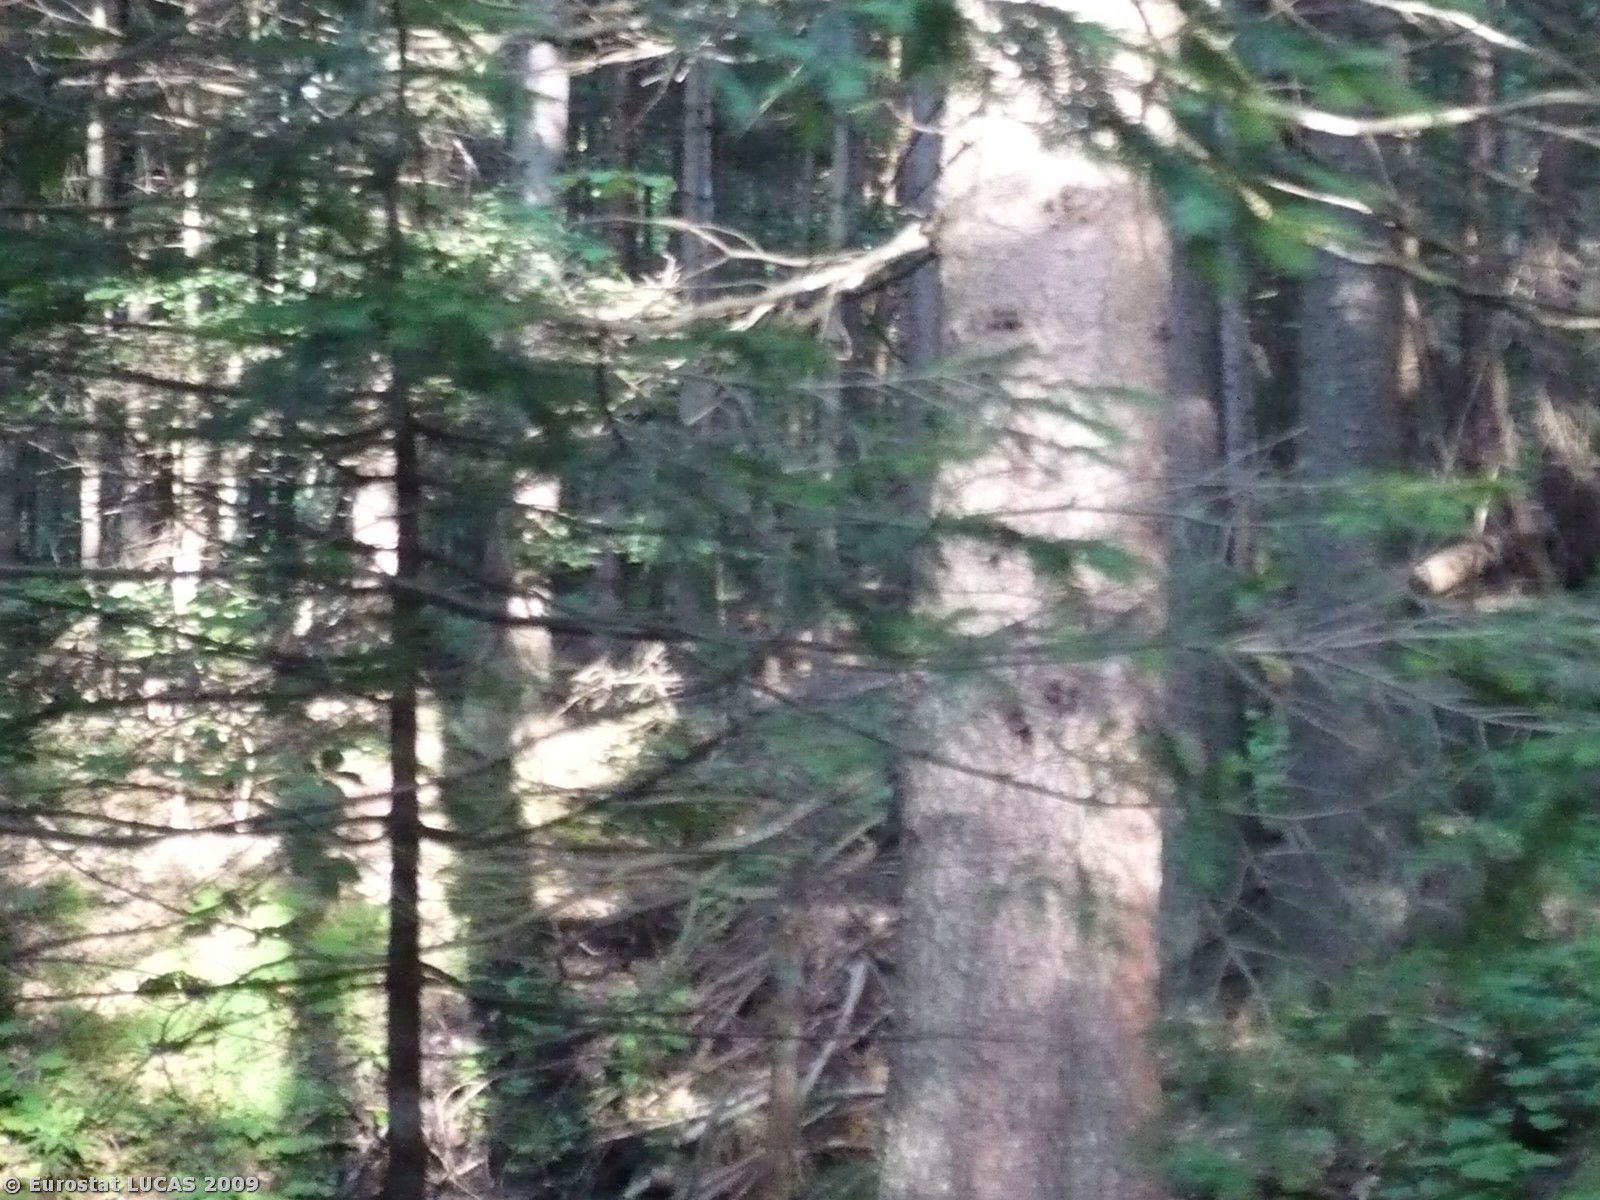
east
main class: Woodland
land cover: Coniferous woodland
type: alpine coniferous forest
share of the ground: > 75 %
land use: Forestry
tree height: > 5 m
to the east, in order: Coniferous woodland; Ditches and canals; Coniferous woodland; Rivers and streams; Mixed woodland; Ditches and canals; Rivers and streams; Ditches and canals; Mixed woodland; Rivers and streams; Mixed woodland; Tracks; Mixed woodland; Rivers and streams; Mixed woodland
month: June
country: SI
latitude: 46.4816
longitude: 13.8136
